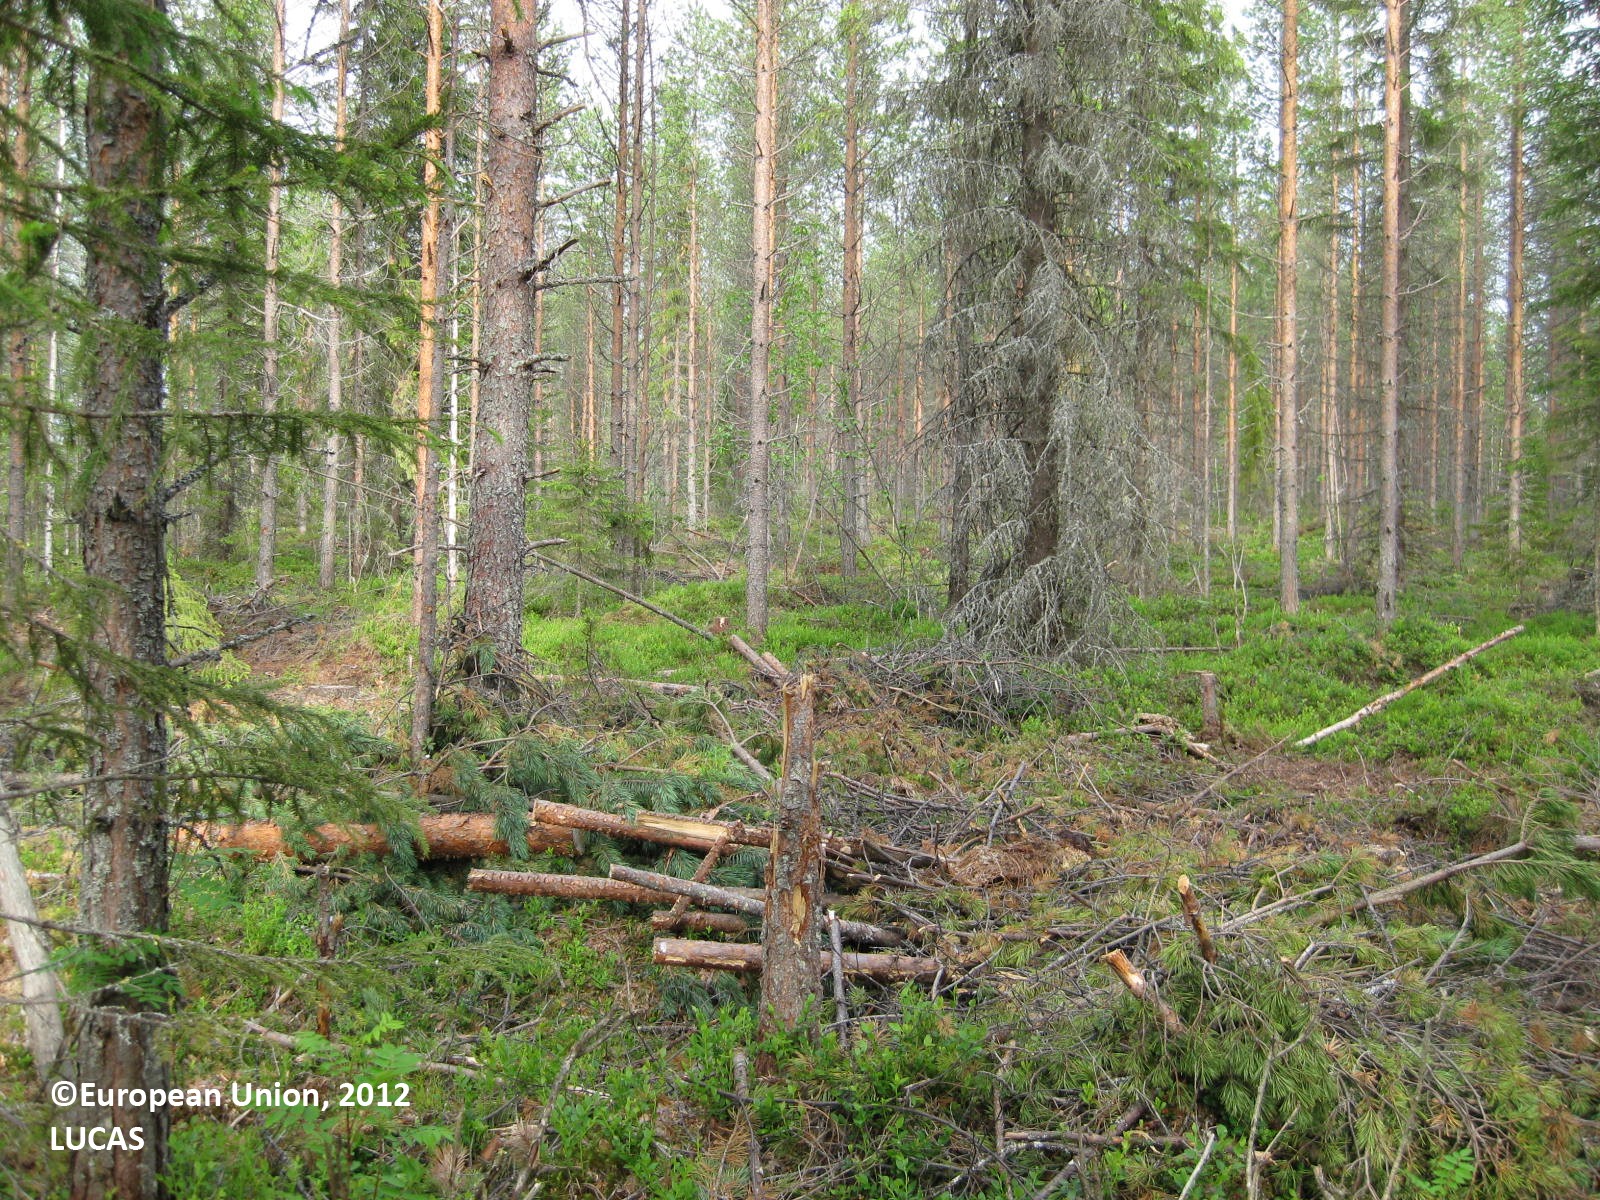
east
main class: Woodland
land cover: Pine dominated coniferous woodland
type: boreal forest
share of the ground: > 75 %
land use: Forestry
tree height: > 5 m
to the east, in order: Pine dominated coniferous woodland; Tracks; Pine dominated coniferous woodland; Tracks; Pine dominated coniferous woodland; Ditches and canals; Pine dominated coniferous woodland; Ditches and canals; Pine dominated coniferous woodland; Ditches and canals; Pine dominated coniferous woodland; Ditches and canals; Pine dominated coniferous woodland; Ditches and canals; Other coniferous woodland; Ditches and canals; Pine dominated coniferous woodland
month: June
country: FI
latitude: 65.2750
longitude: 28.1741
